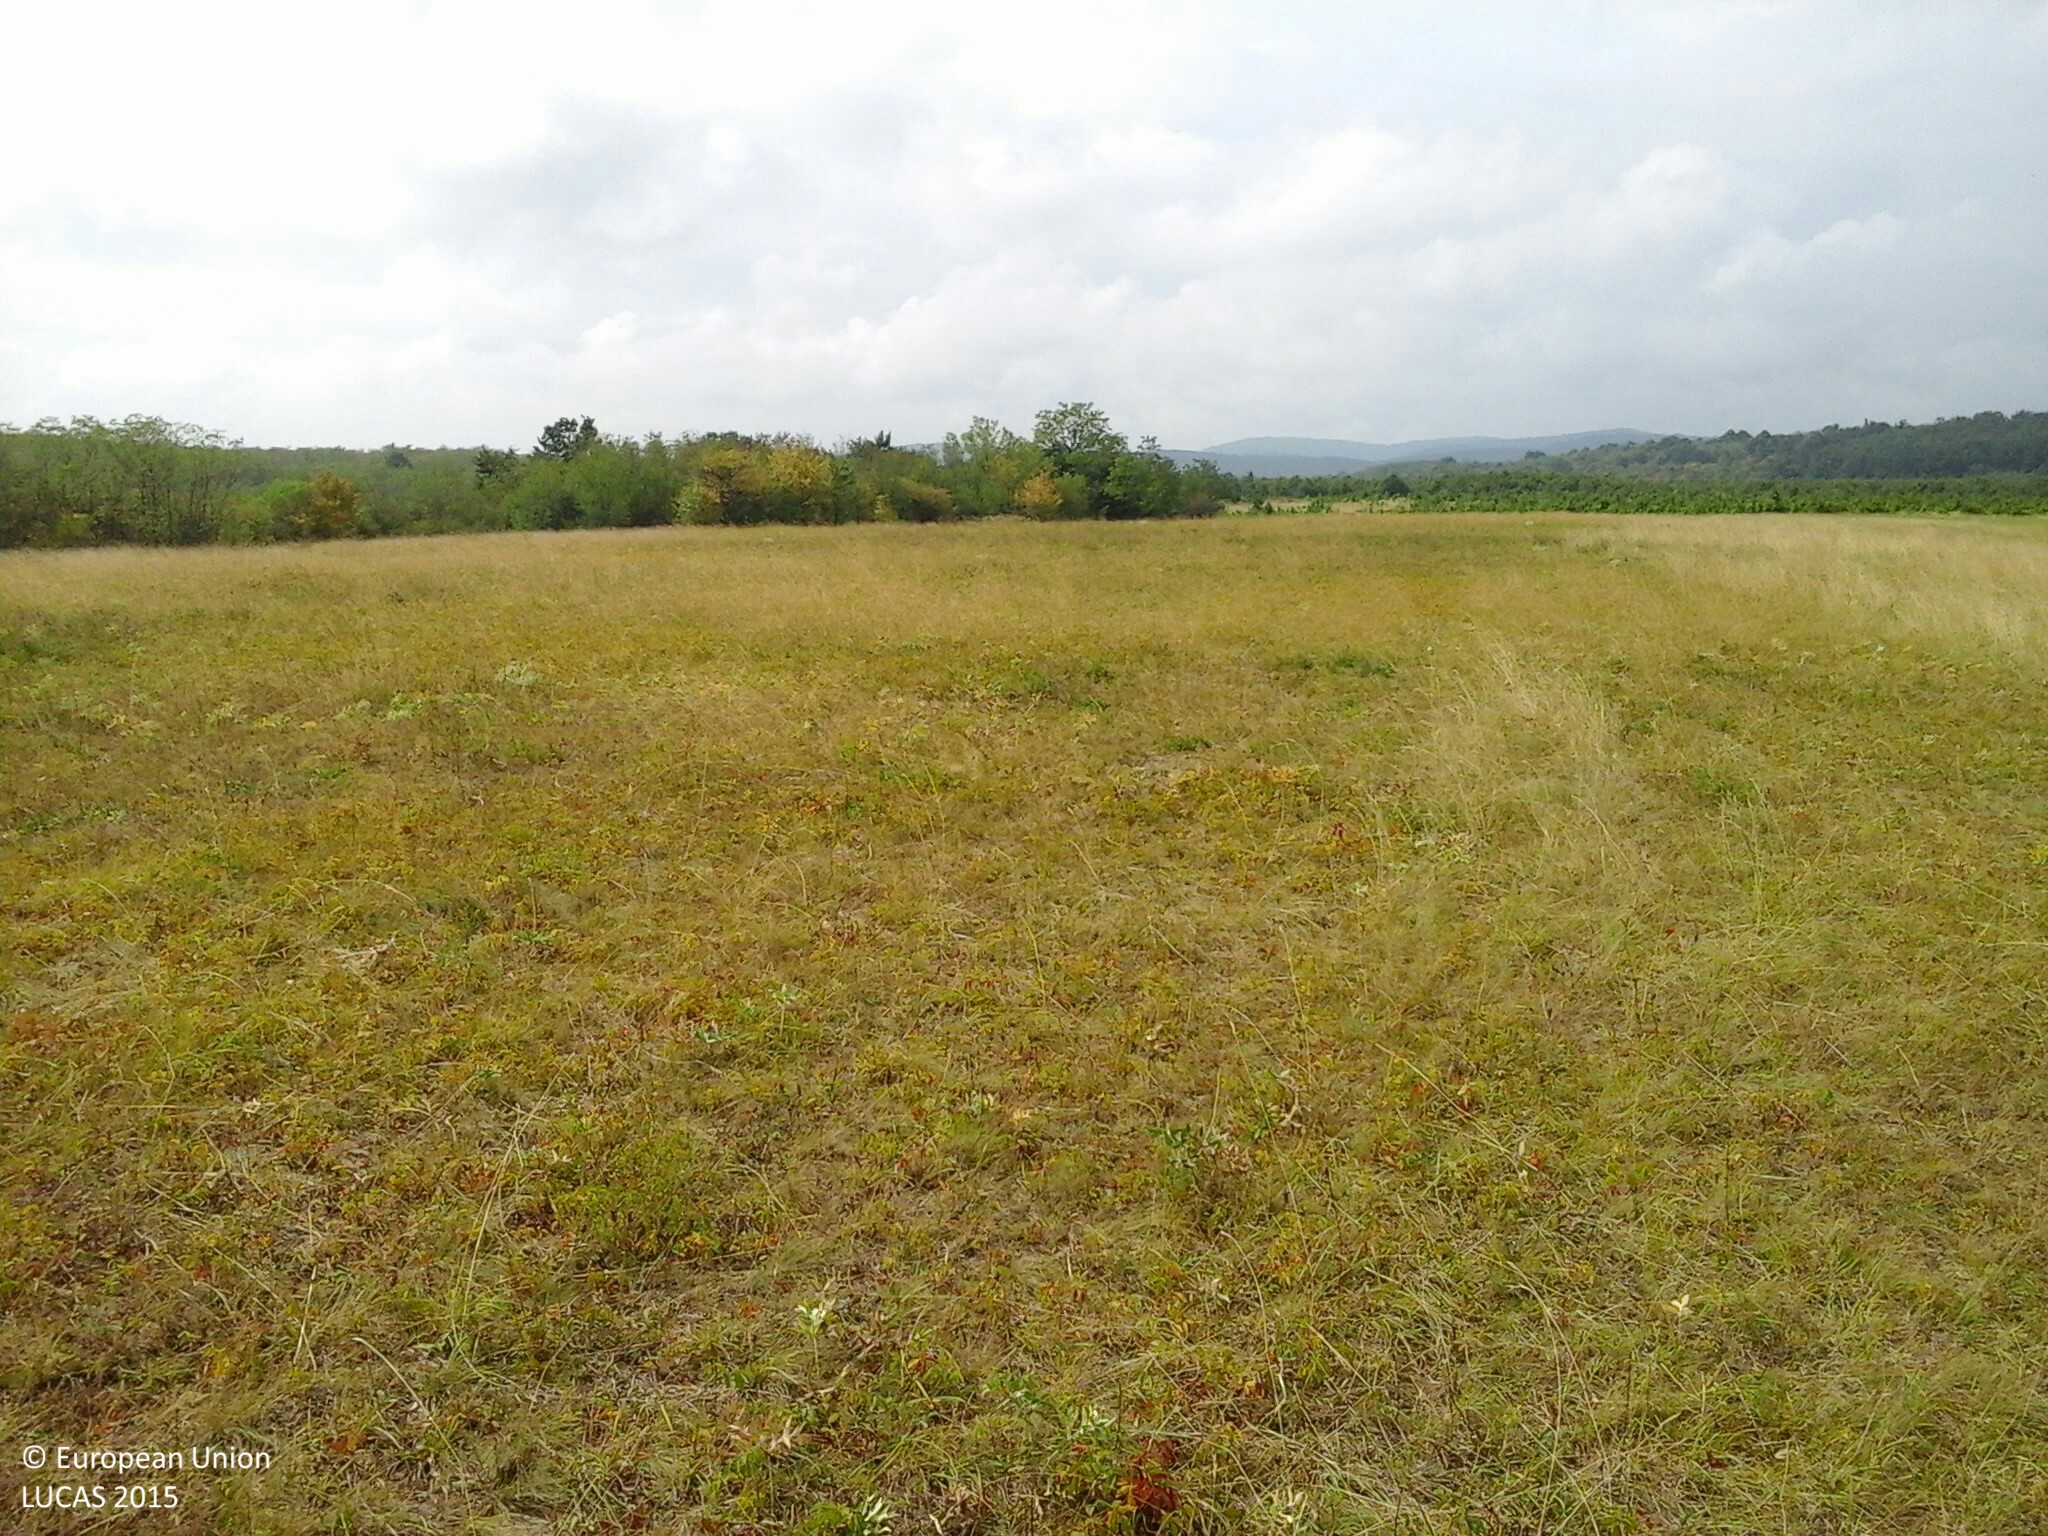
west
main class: Grassland
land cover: Grassland without tree/shrub cover
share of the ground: > 75 %
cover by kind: herbaceous plants 100 %
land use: Agriculture (excluding fallow land and kitchen gardens)
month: August
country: HU
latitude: 47.9775
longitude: 20.6584
